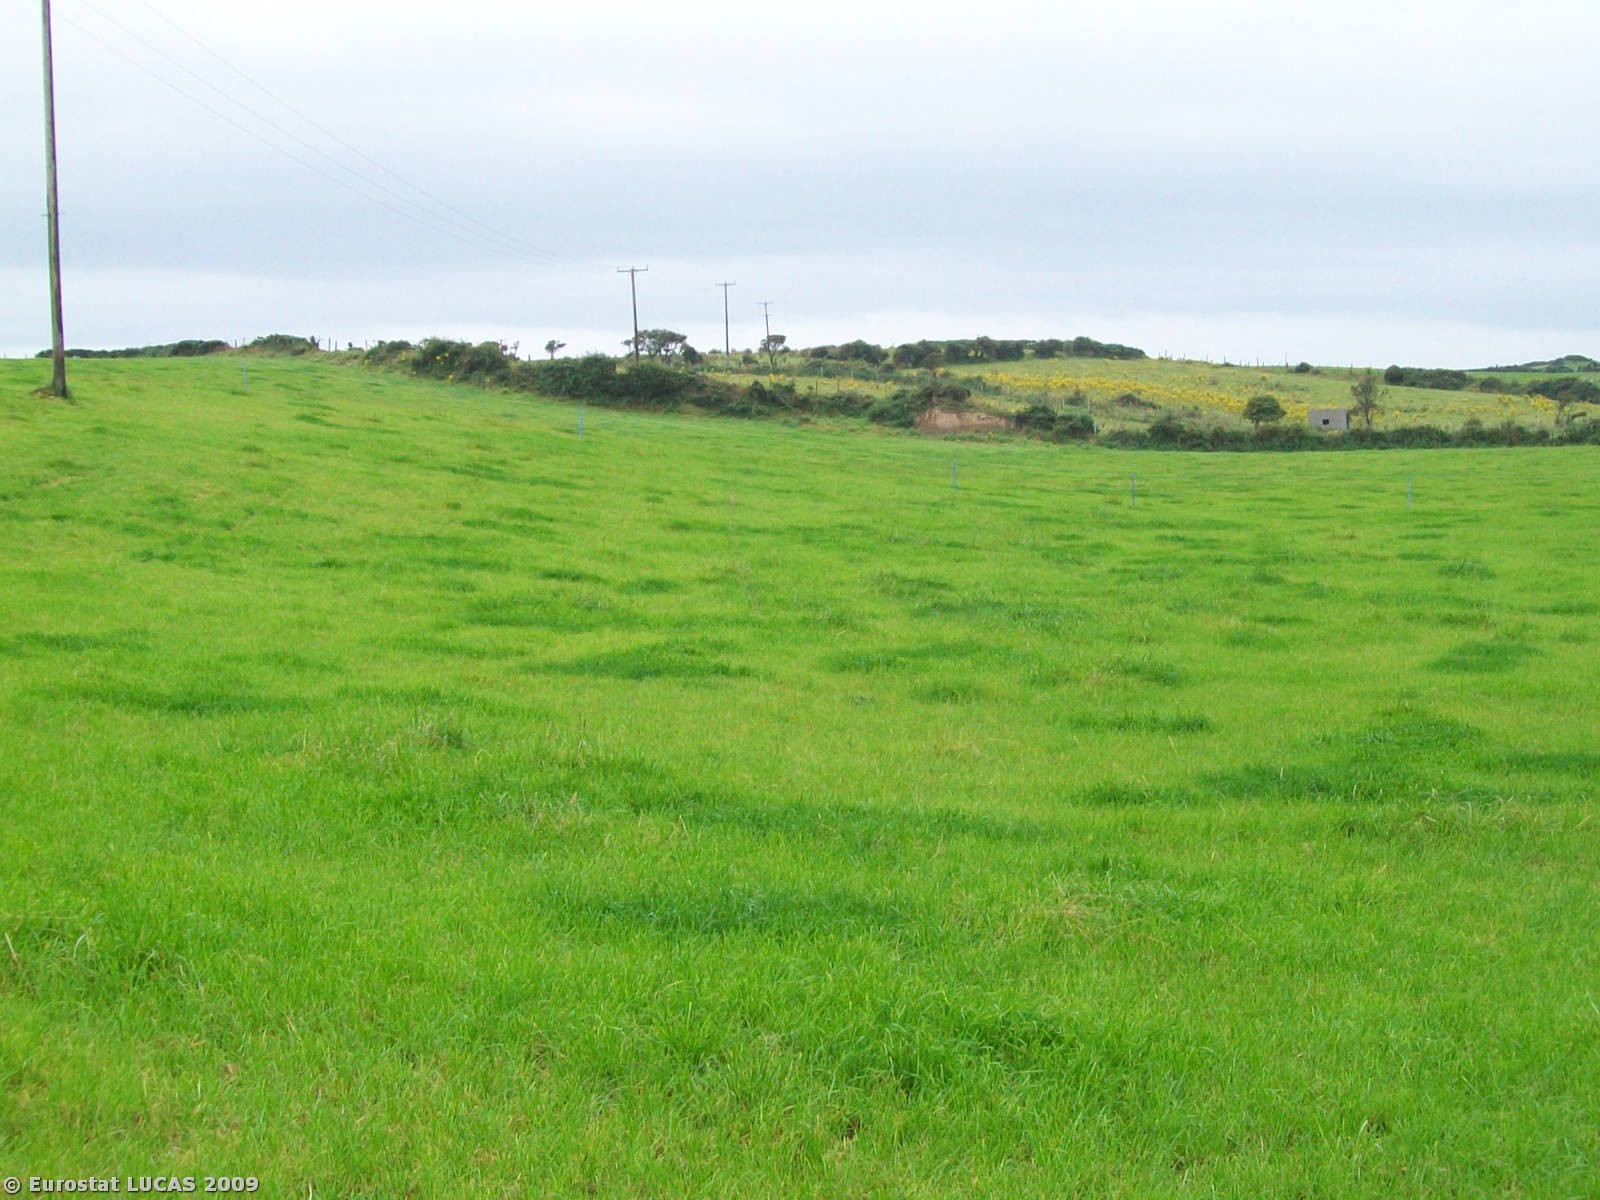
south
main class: Grassland
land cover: Spontaneously vegetated surfaces
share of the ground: > 75 %
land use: Fallow land
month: August
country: GB
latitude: 54.3142
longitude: -5.5468
